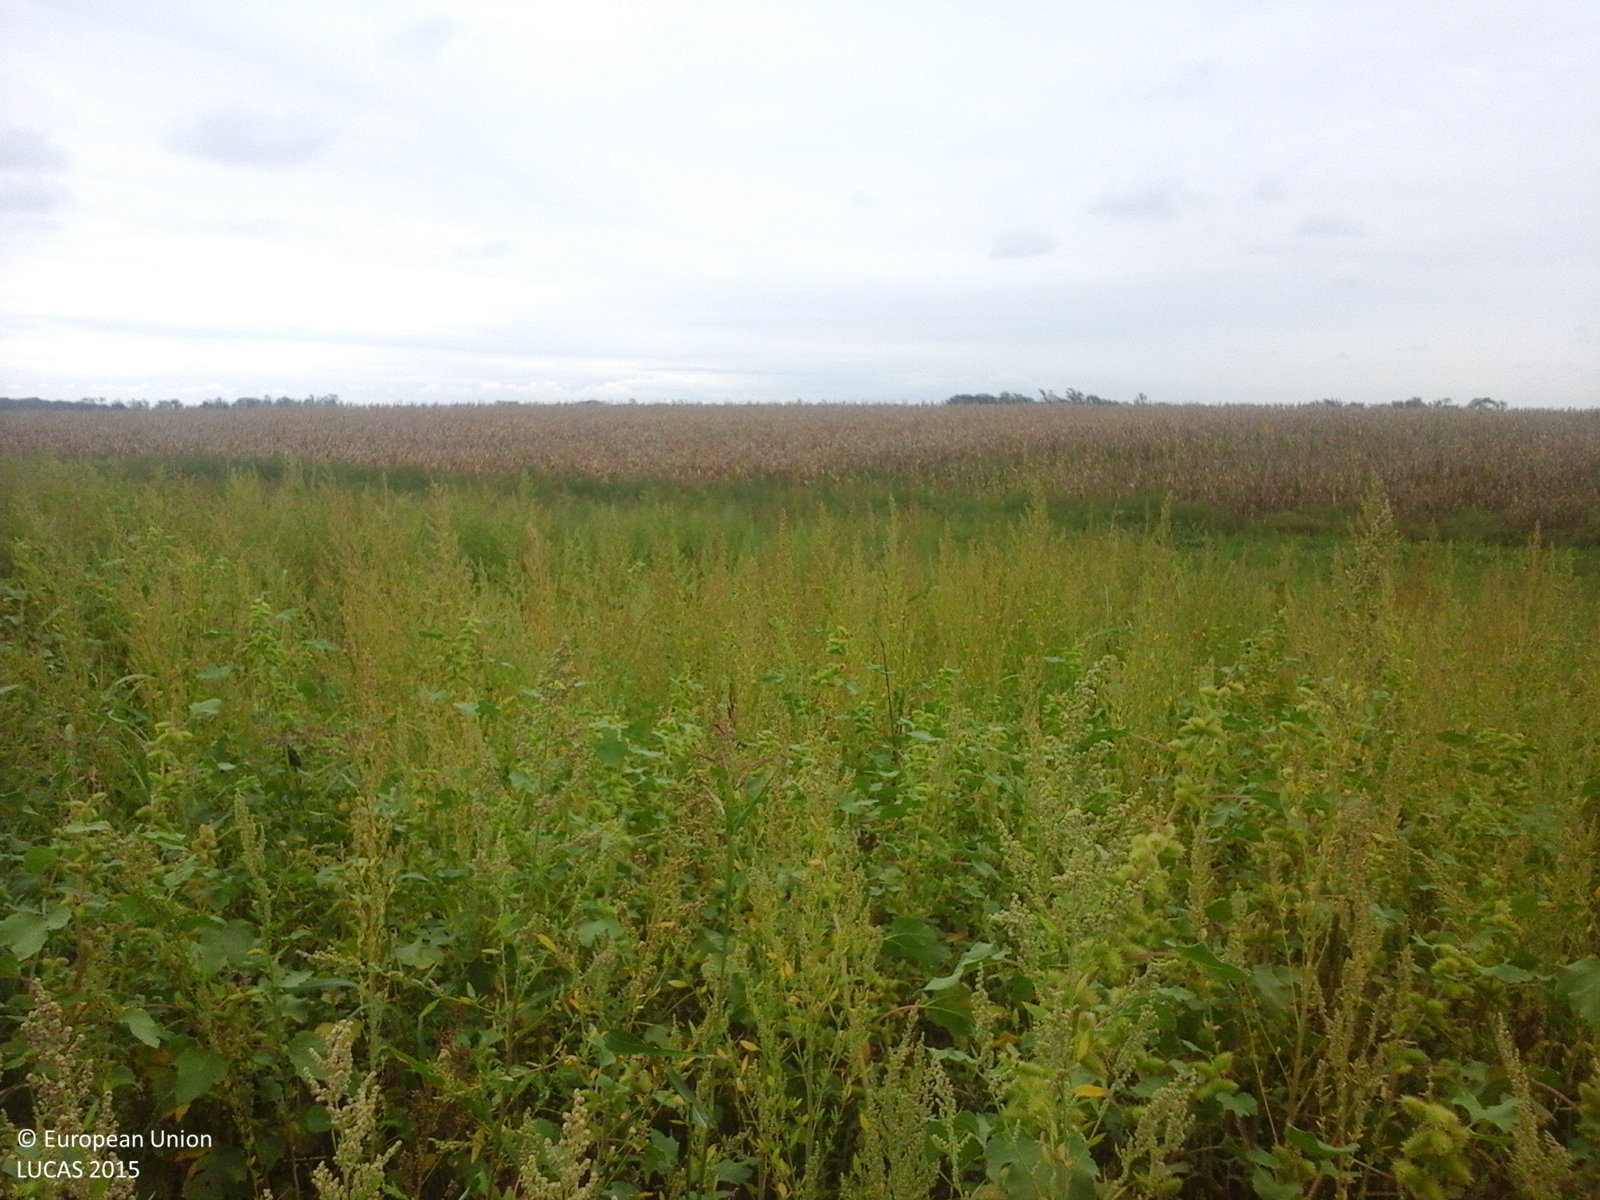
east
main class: Grassland
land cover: Spontaneously vegetated surfaces
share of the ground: > 75 %
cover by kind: herbaceous plants 100 %
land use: Agriculture (excluding fallow land and kitchen gardens)
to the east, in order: Spontaneously vegetated surfaces; Maize; Grass margins; Tracks; Grass margins; Maize; Shruby margins; Maize; Sunflower; Spontaneously vegetated surfaces; Sunflower; Maize
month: September
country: RO
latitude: 47.3201
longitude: 21.9150
